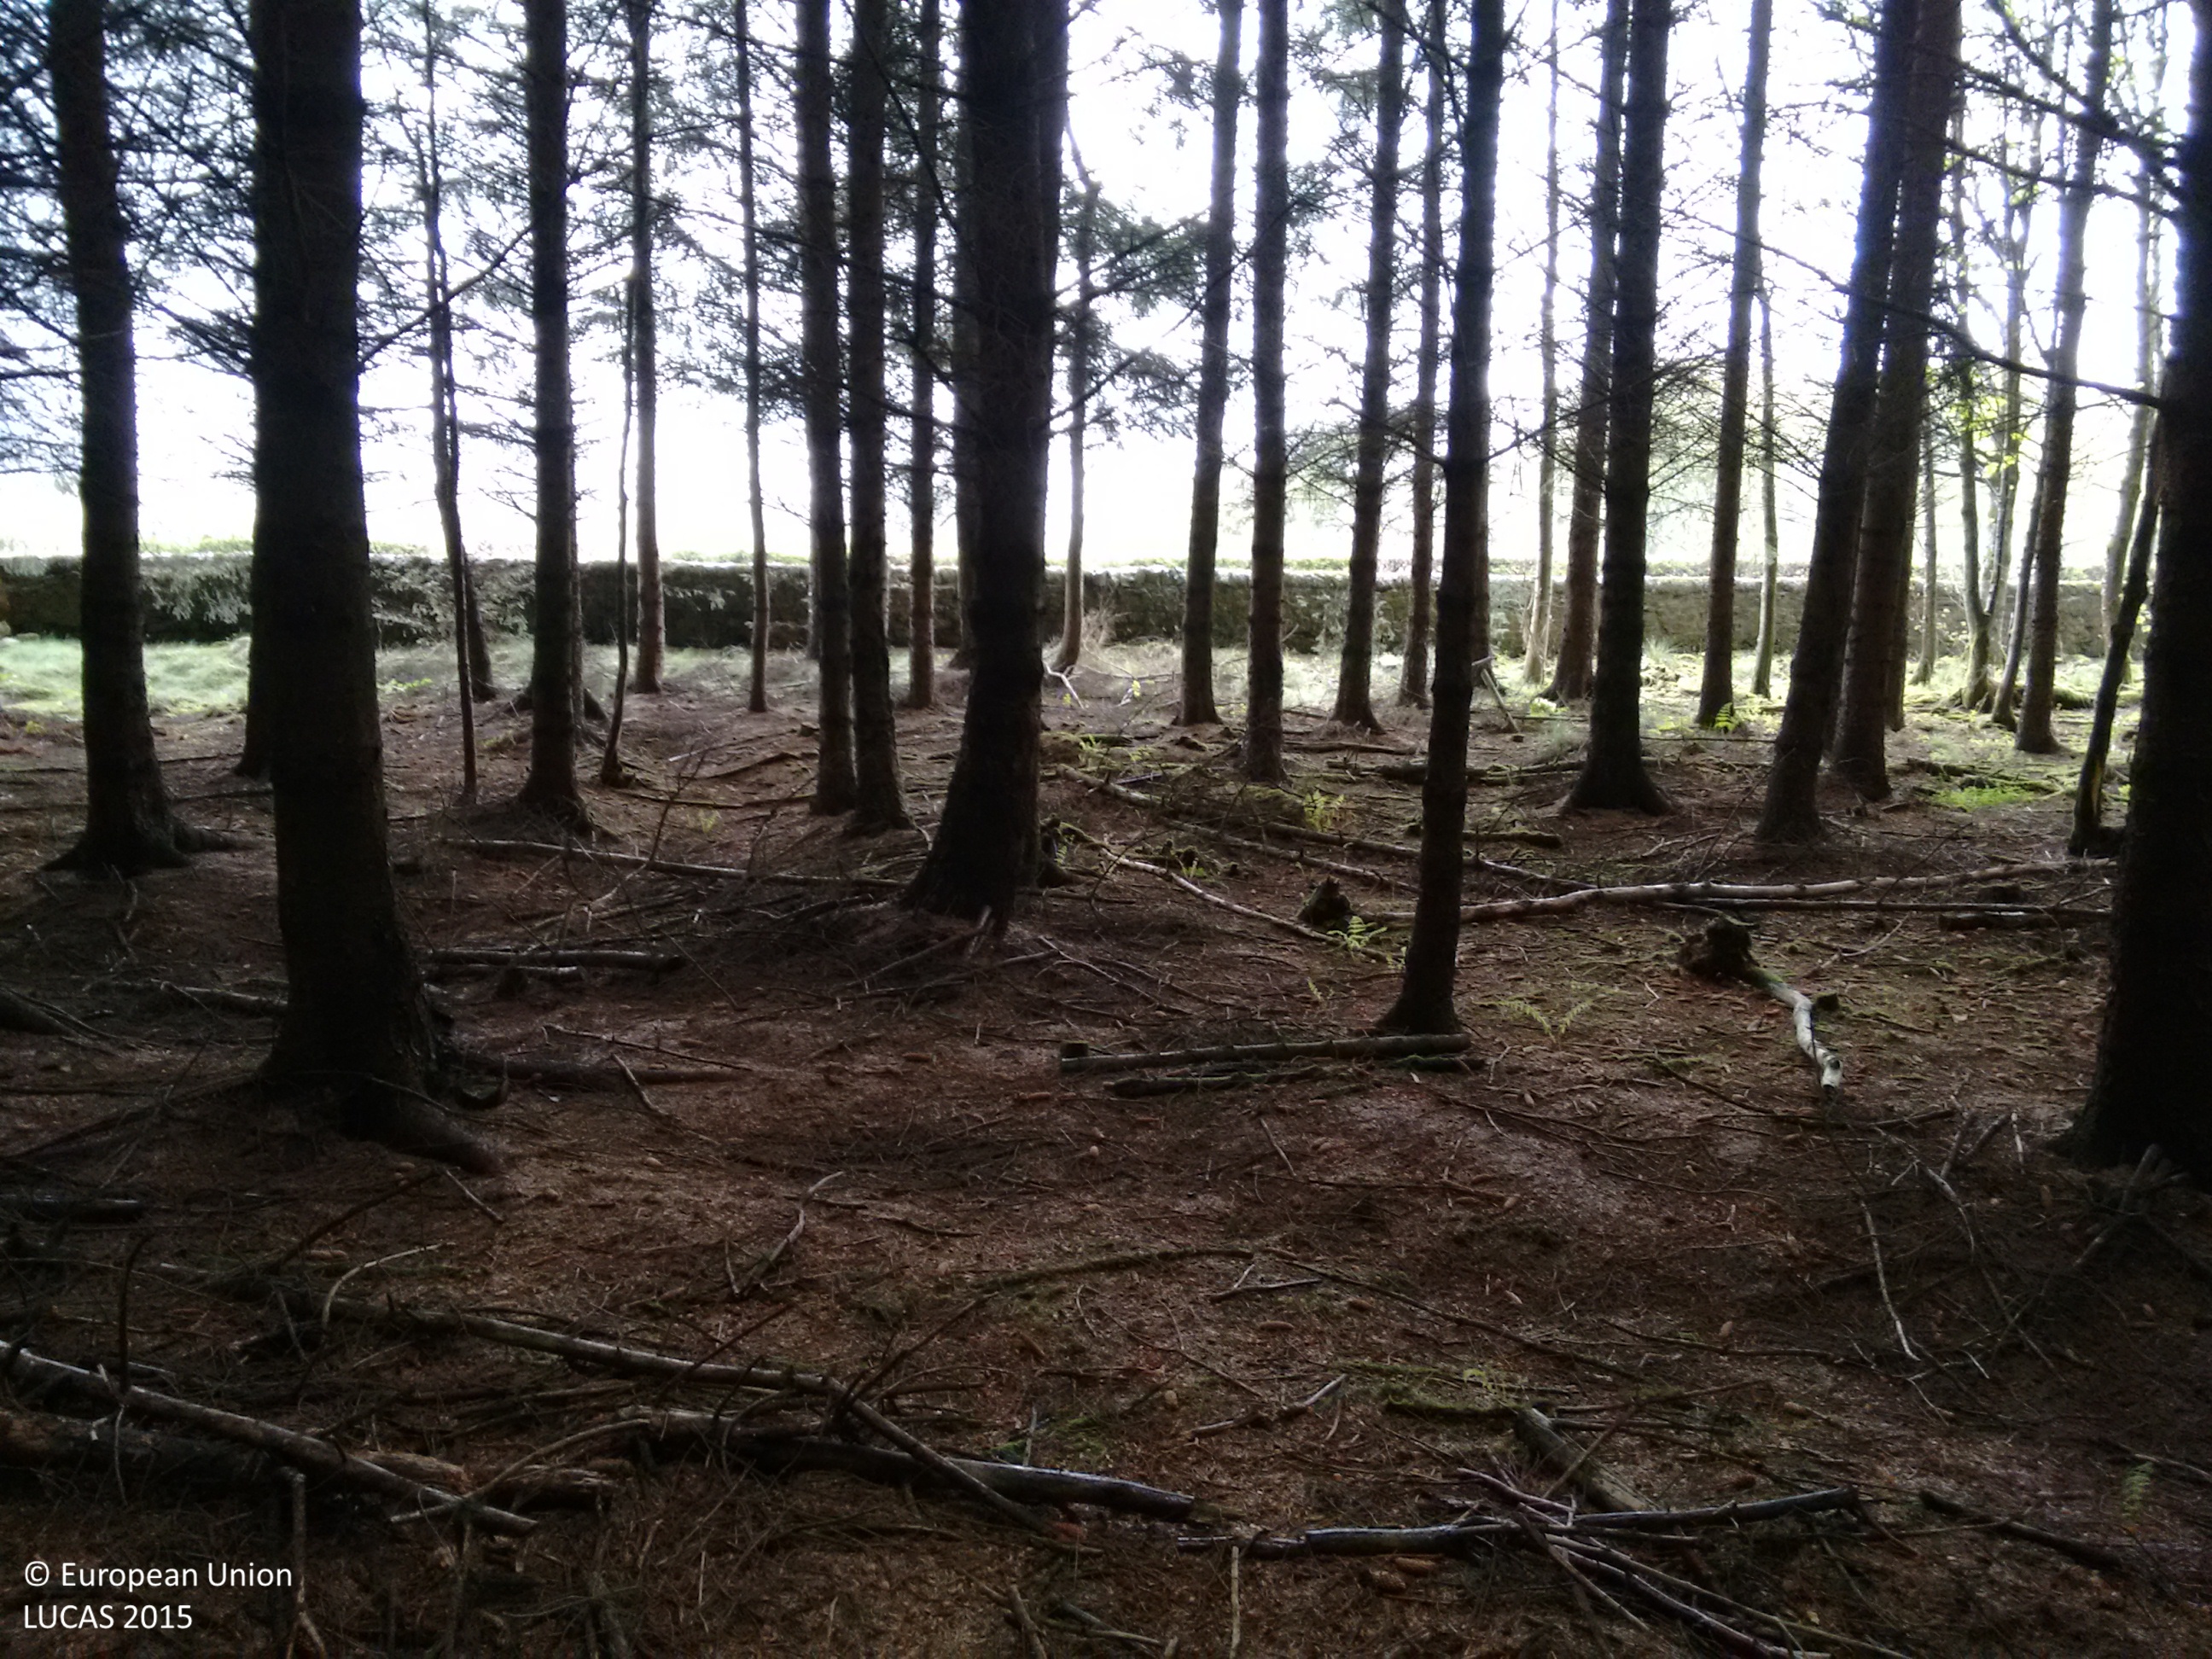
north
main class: Woodland
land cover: Spruce dominated coniferous woodland
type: exotic forest
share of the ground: > 75 %
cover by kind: coniferous forest trees 95 %, unconsolidated bare surface 5 %
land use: Forestry
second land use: Amenities, museums, leisure
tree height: > 5 m
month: May
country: GB
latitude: 55.8259
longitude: -3.2424
